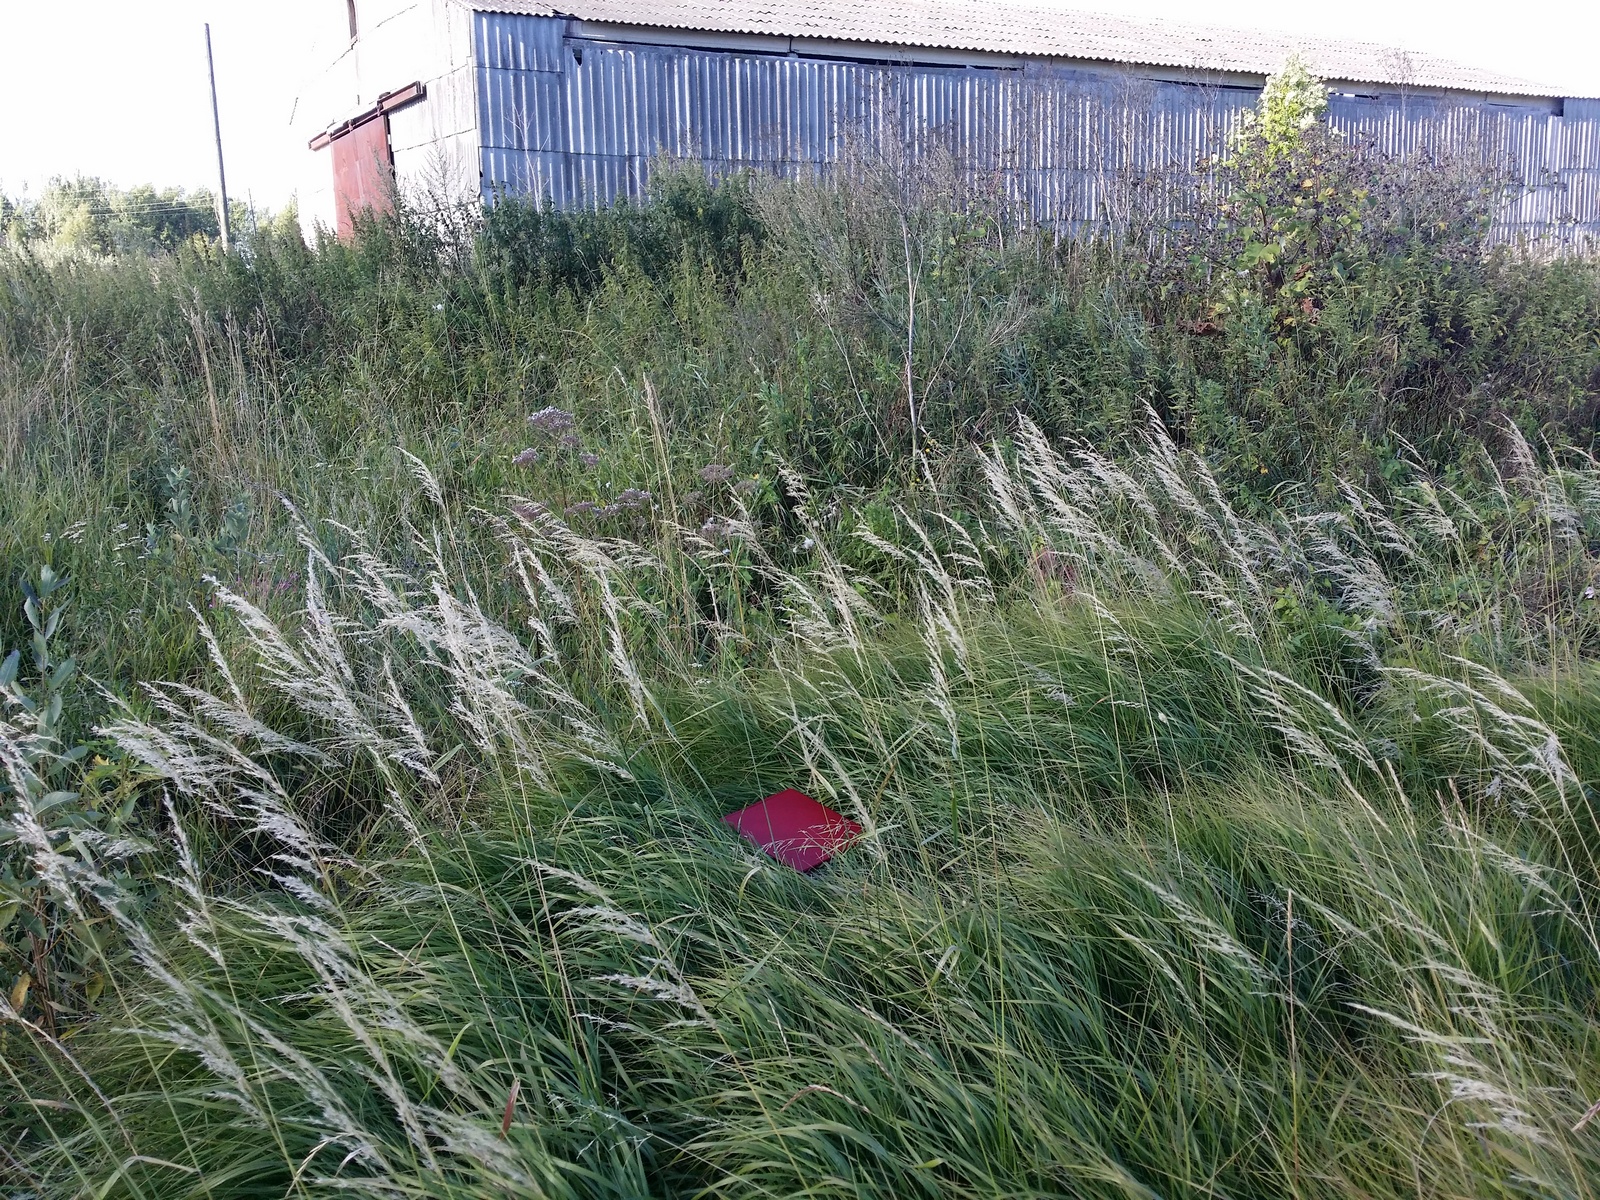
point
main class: Grassland
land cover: Spontaneously vegetated surfaces
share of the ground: > 75 %
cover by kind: herbaceous plants 100 %
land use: Semi-natural and natural areas not in use
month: August
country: LV
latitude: 57.1729
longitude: 27.7320
